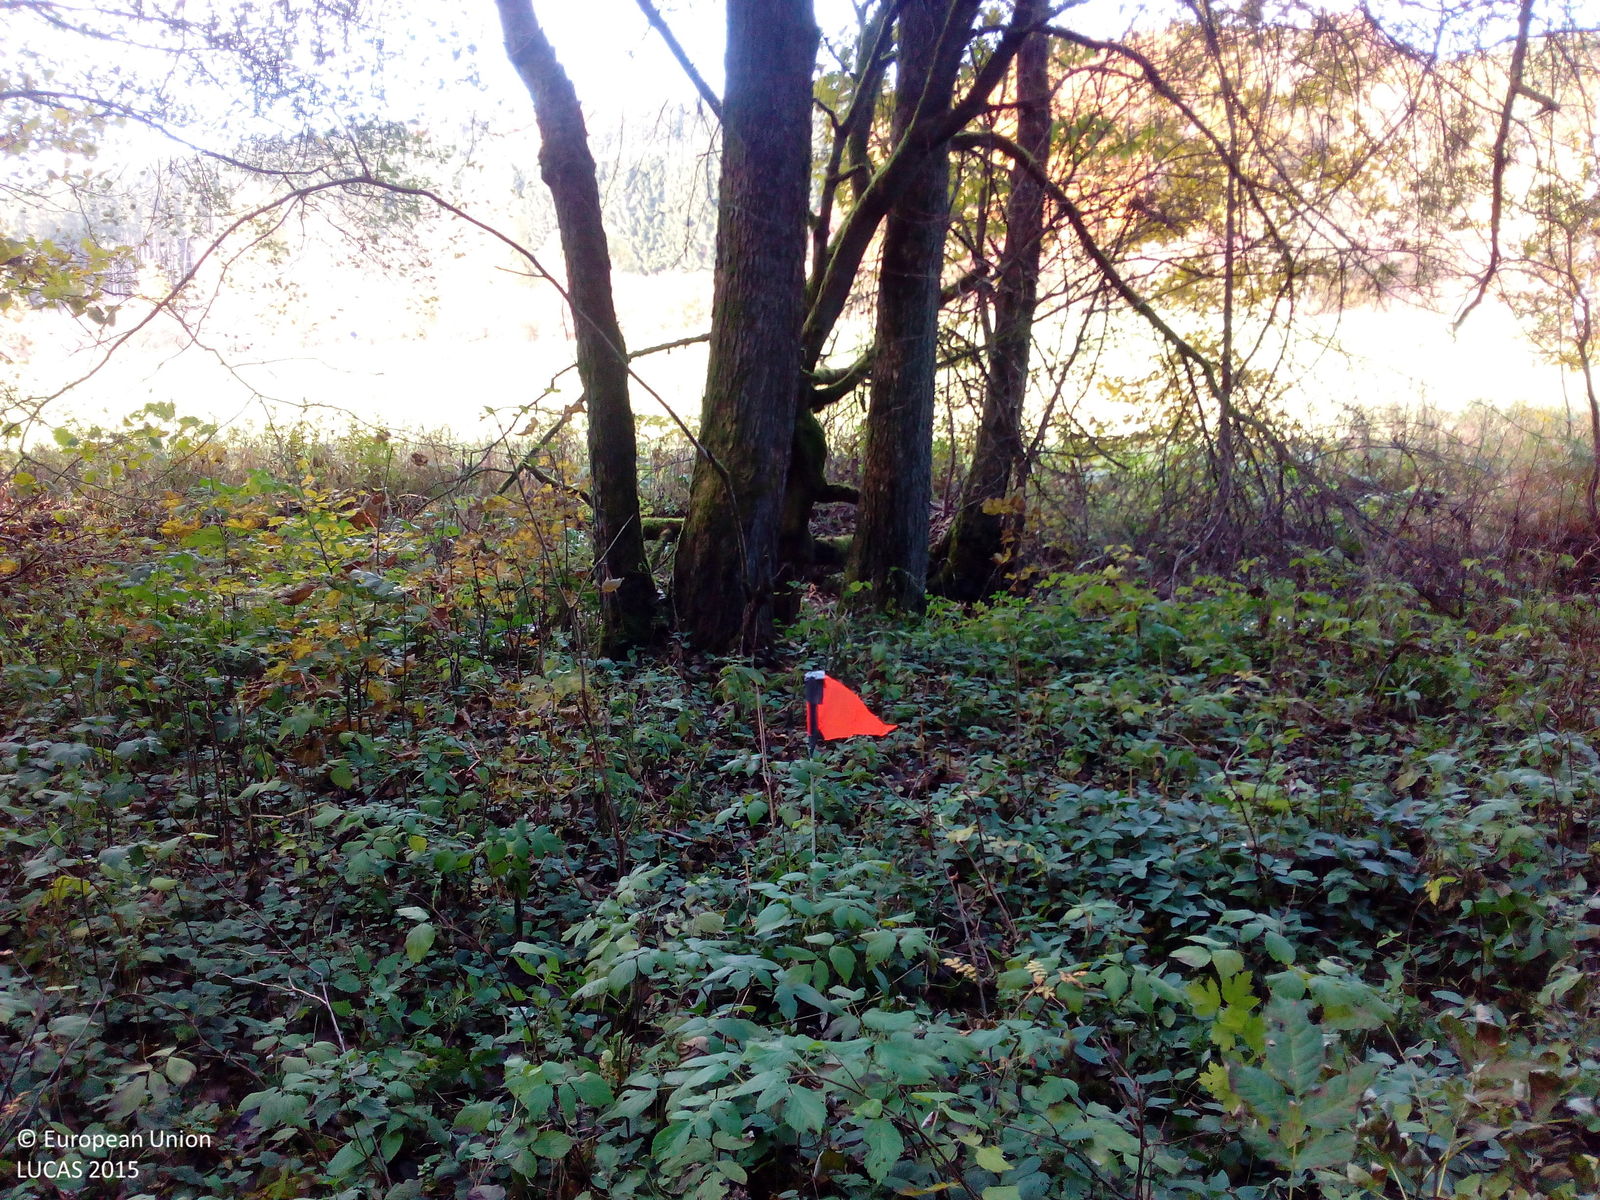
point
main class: Woodland
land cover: Broadleaved woodland
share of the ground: 50 - 75 %
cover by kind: broadleaved forest trees 45 %, coniferous forest trees 15 %, herbaceous plants 15 %, lichens and mosses 10 %, unconsolidated bare surface 10 %, shrubs 5 %
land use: Forestry
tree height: > 5 m
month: October
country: DE
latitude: 50.3820
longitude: 9.9297
